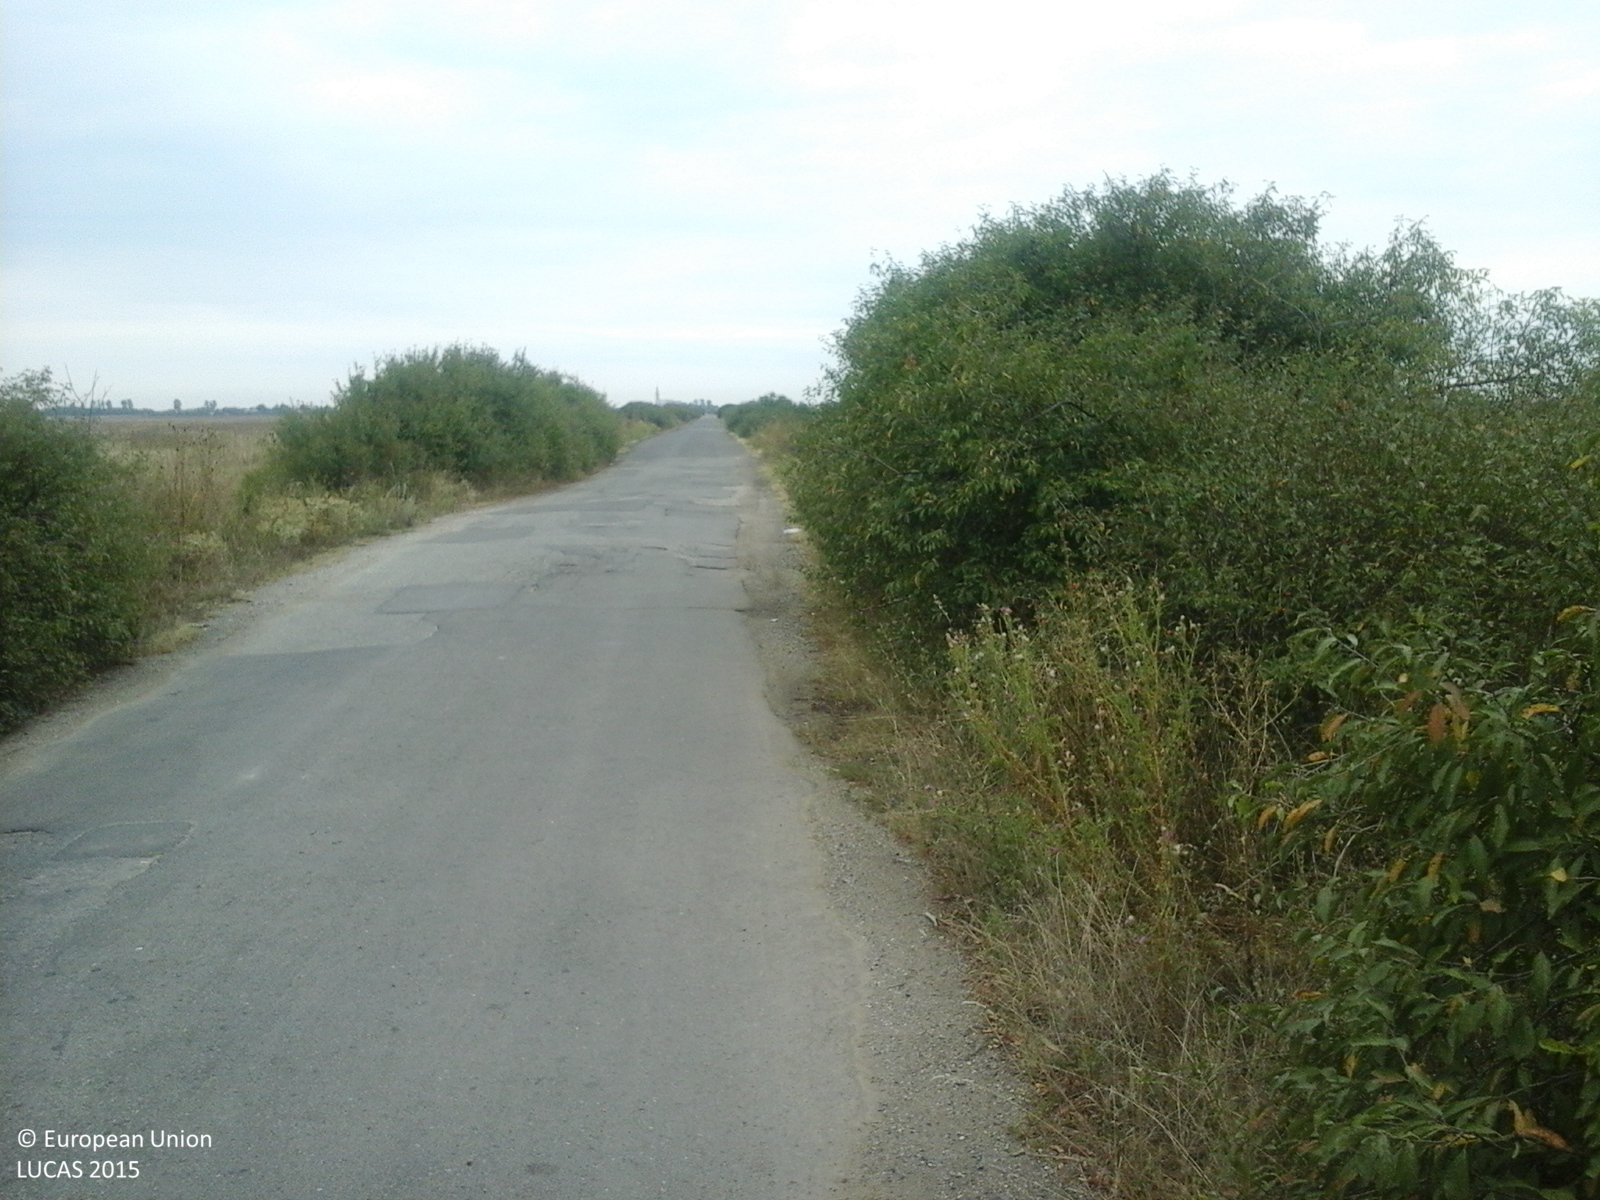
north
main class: Shrubland
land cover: Shrubland without tree cover
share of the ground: > 75 %
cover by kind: shrubs 100 %
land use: Semi-natural and natural areas not in use
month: September
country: RO
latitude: 47.6531
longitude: 22.6687
